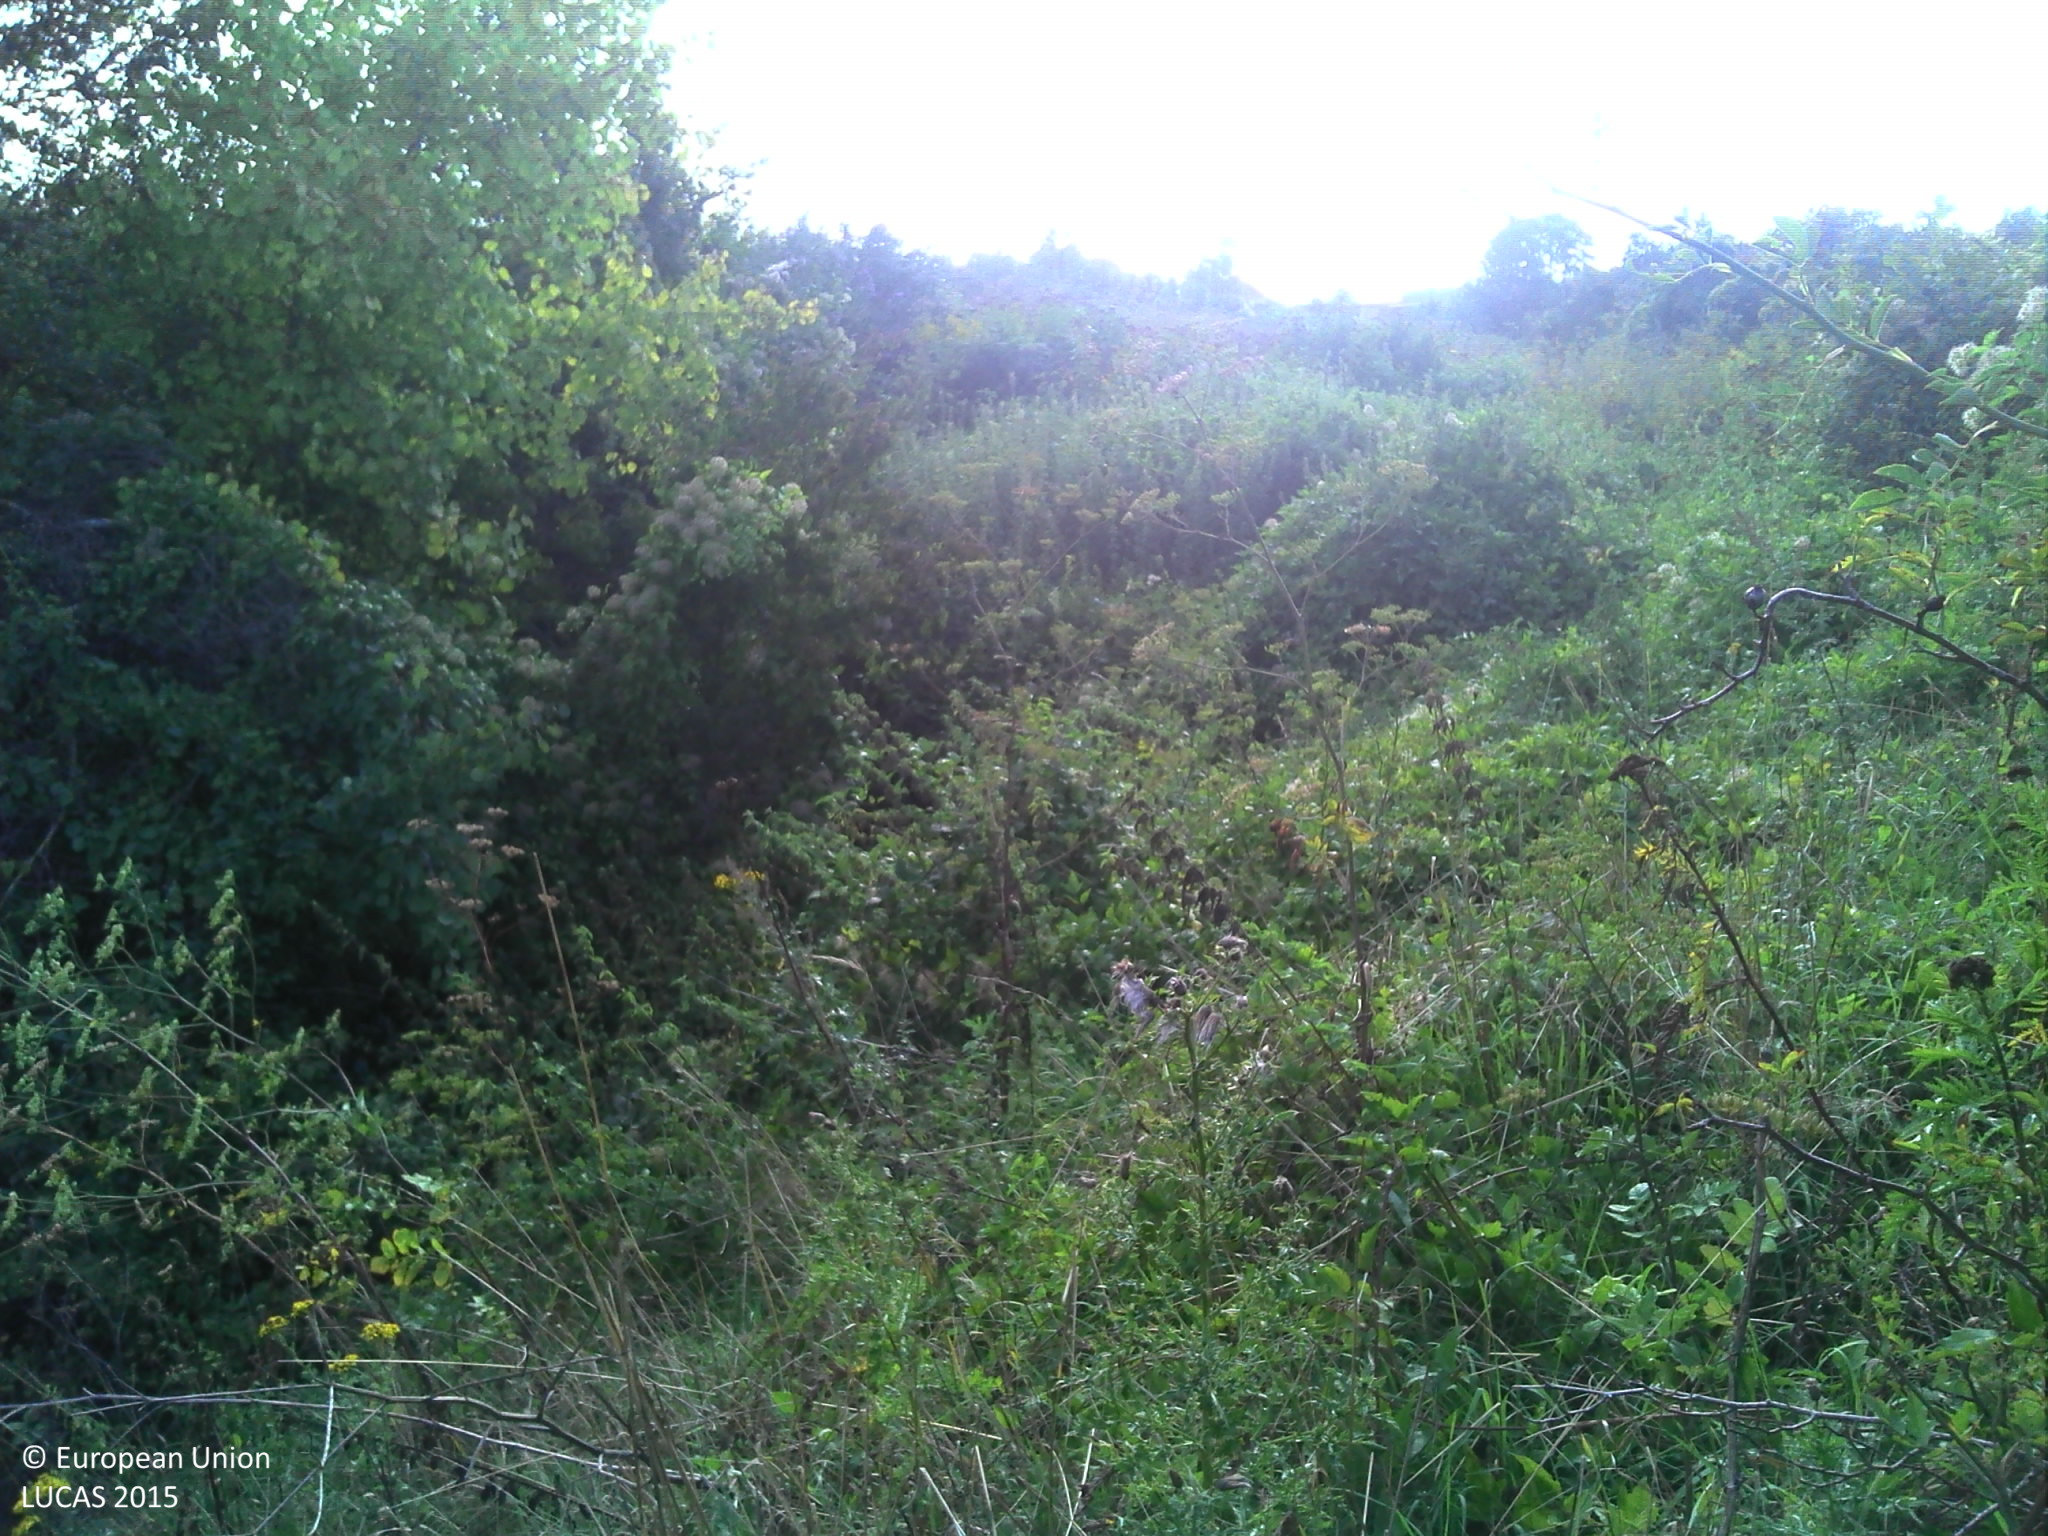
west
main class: Shrubland
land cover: Shrubland with sparse tree cover
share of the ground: > 75 %
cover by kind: shrubs 50 %, herbaceous plants 30 %, consolidated bare surface 15 %, broadleaved forest trees 5 %
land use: Semi-natural and natural areas not in use
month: September
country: FR
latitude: 49.2120
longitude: 5.9498
